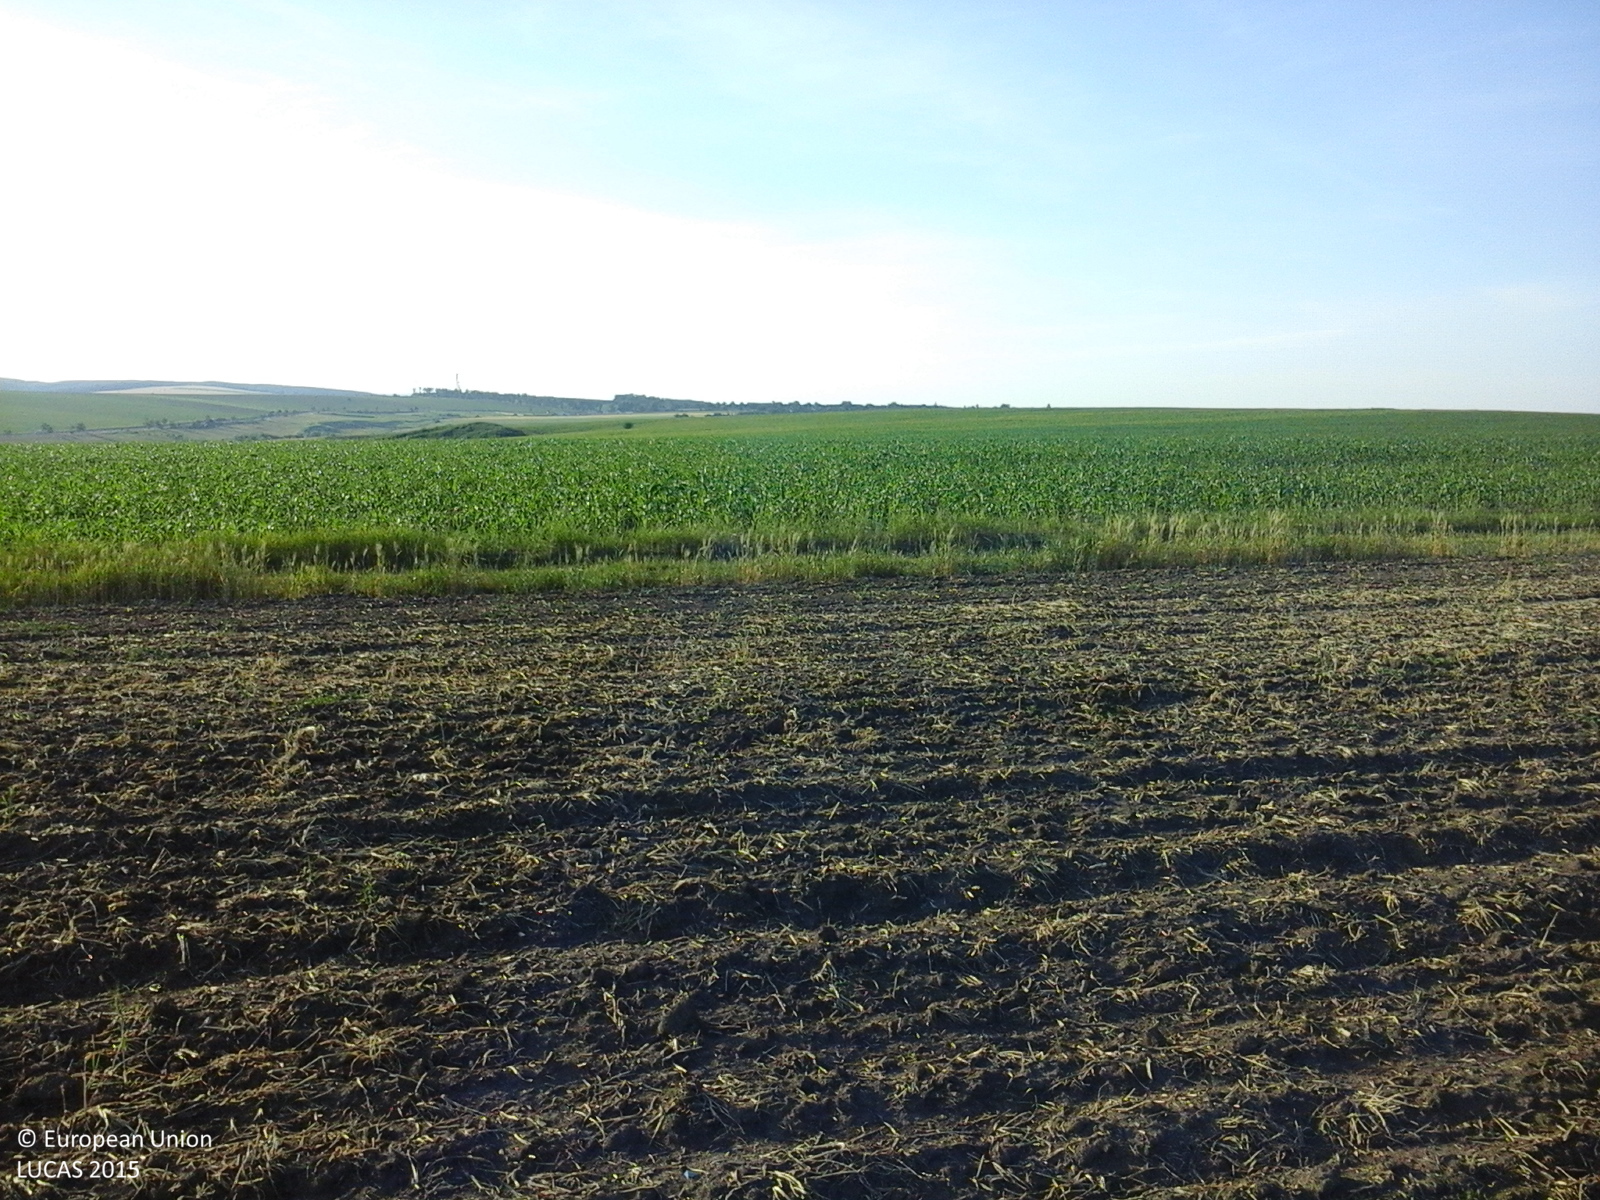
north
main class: Cropland
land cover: Common wheat
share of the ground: < 10 %
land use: Agriculture (excluding fallow land and kitchen gardens)
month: June
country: RO
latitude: 47.0961
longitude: 26.9765
